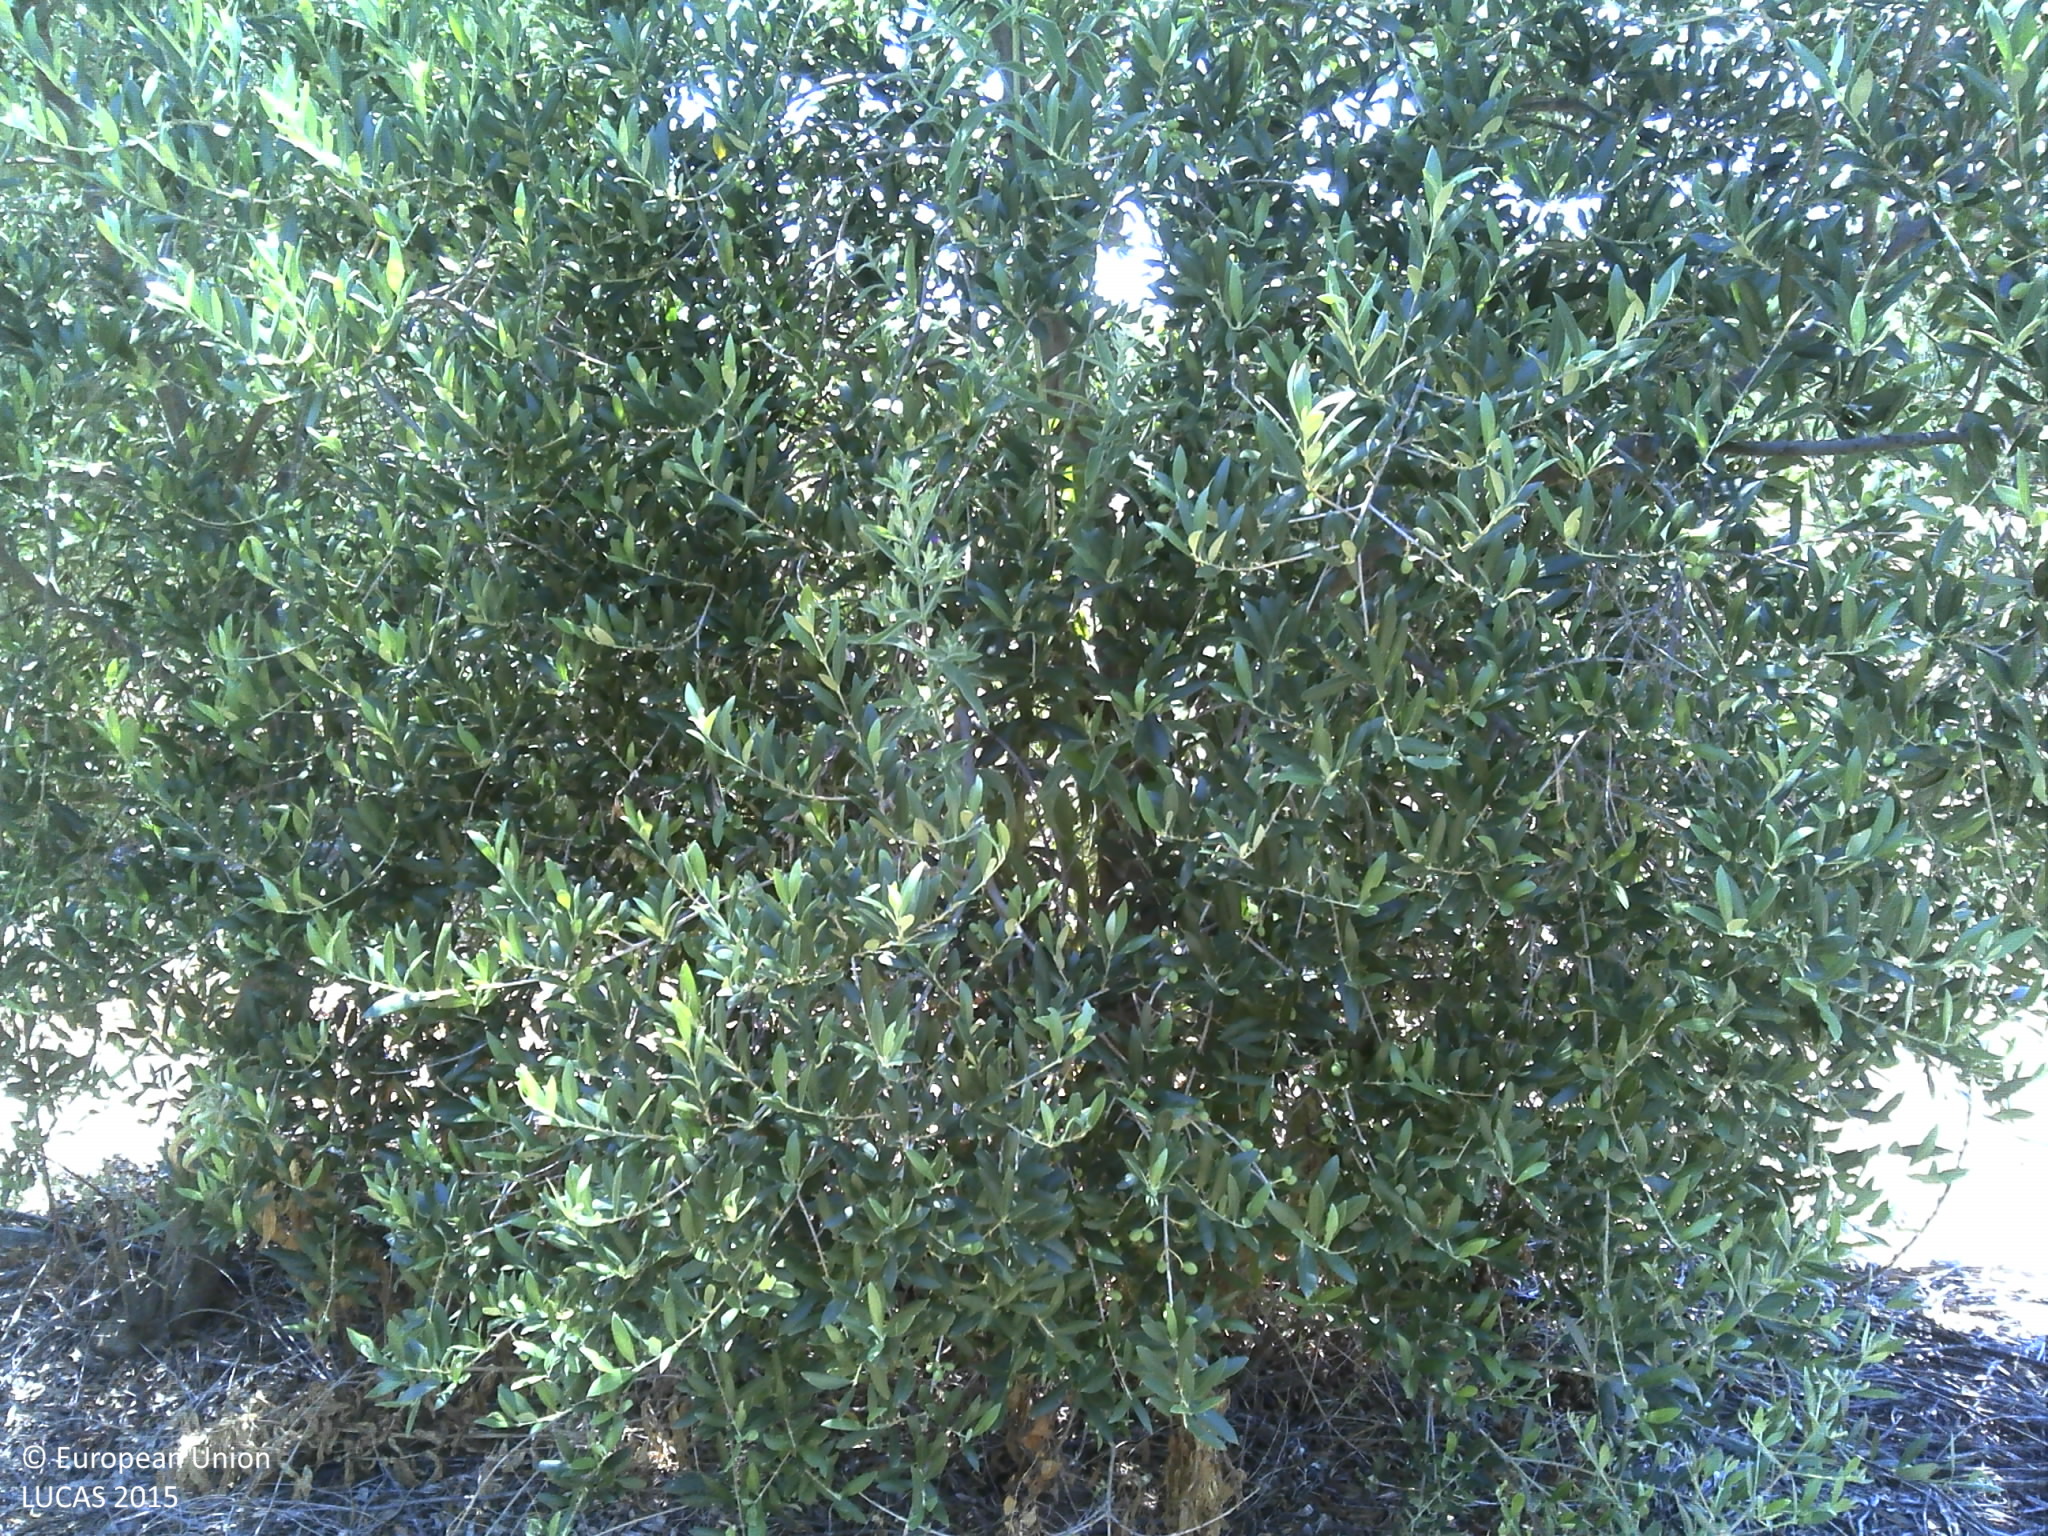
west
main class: Cropland
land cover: Olive groves
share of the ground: 50 - 75 %
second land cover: Grassland without tree/shrub cover
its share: 25 - 50 %
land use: Agriculture (excluding fallow land and kitchen gardens)
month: June
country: PT
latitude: 37.9538
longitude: -7.5341
